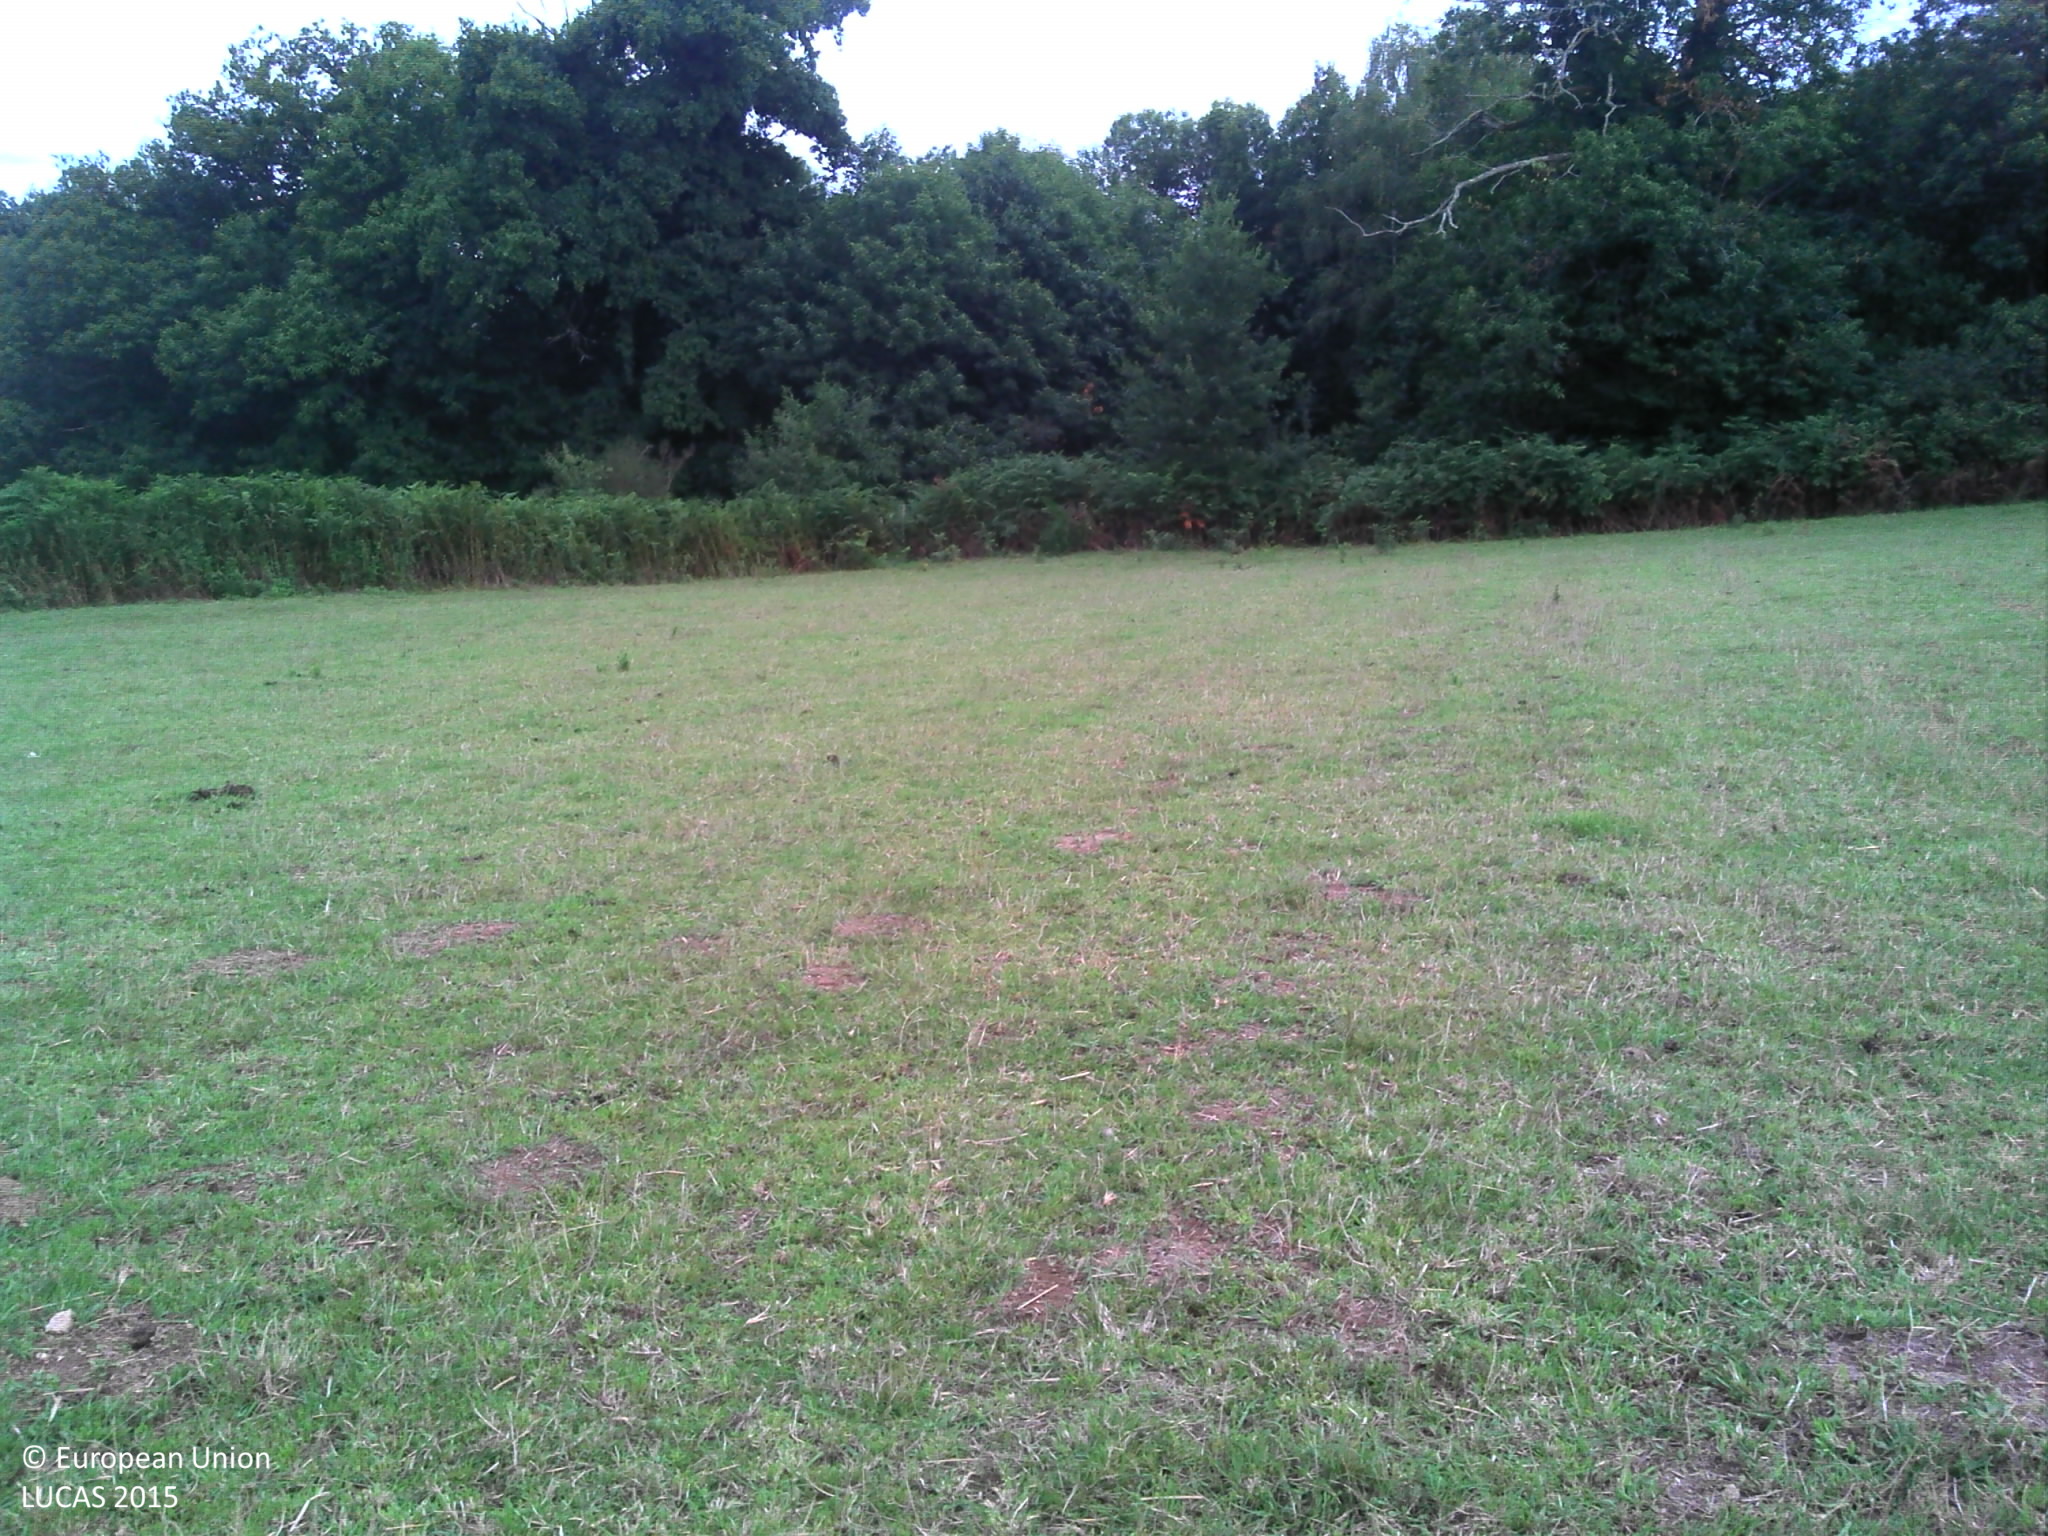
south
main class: Grassland
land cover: Grassland without tree/shrub cover
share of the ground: > 75 %
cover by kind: herbaceous plants 100 %
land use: Agriculture (excluding fallow land and kitchen gardens)
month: August
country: FR
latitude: 46.1172
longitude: 1.2292
